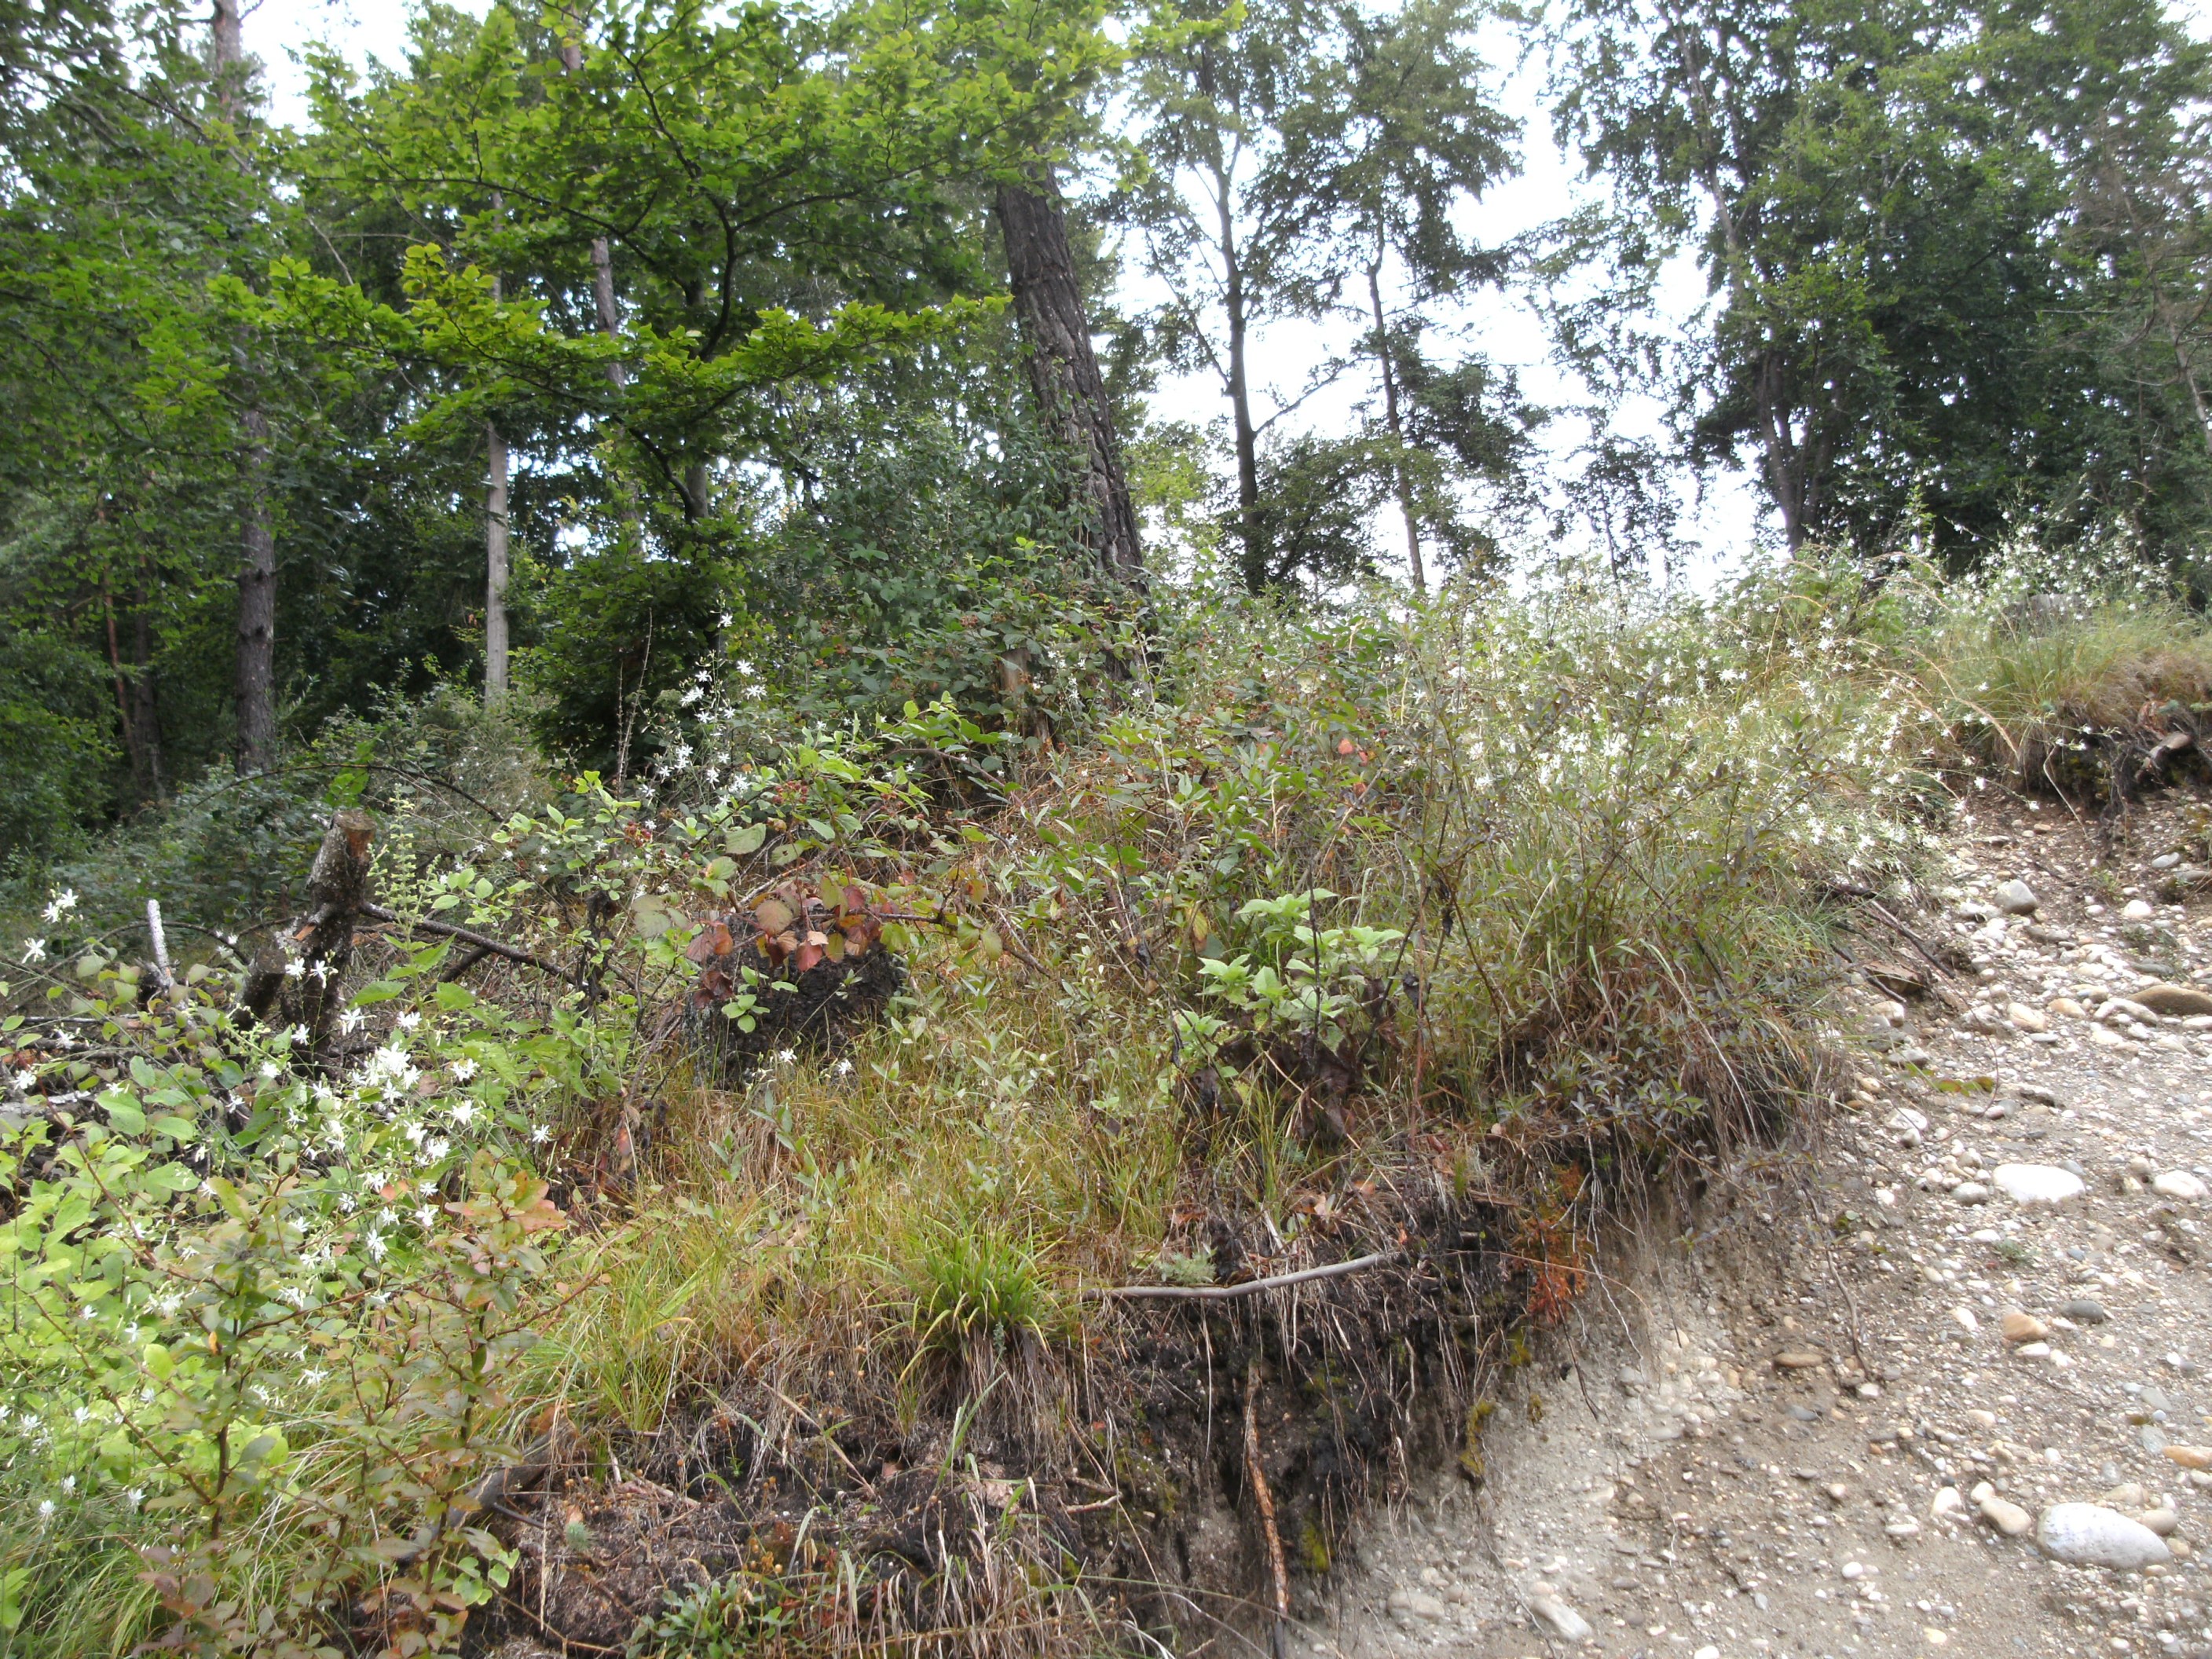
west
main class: Grassland
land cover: Spontaneously vegetated surfaces
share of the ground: 25 - 50 %
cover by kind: unconsolidated bare surface 50 %, herbaceous plants 45 %, shrubs 5 %
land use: Forestry
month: July
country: AT
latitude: 46.6273
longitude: 14.6866
